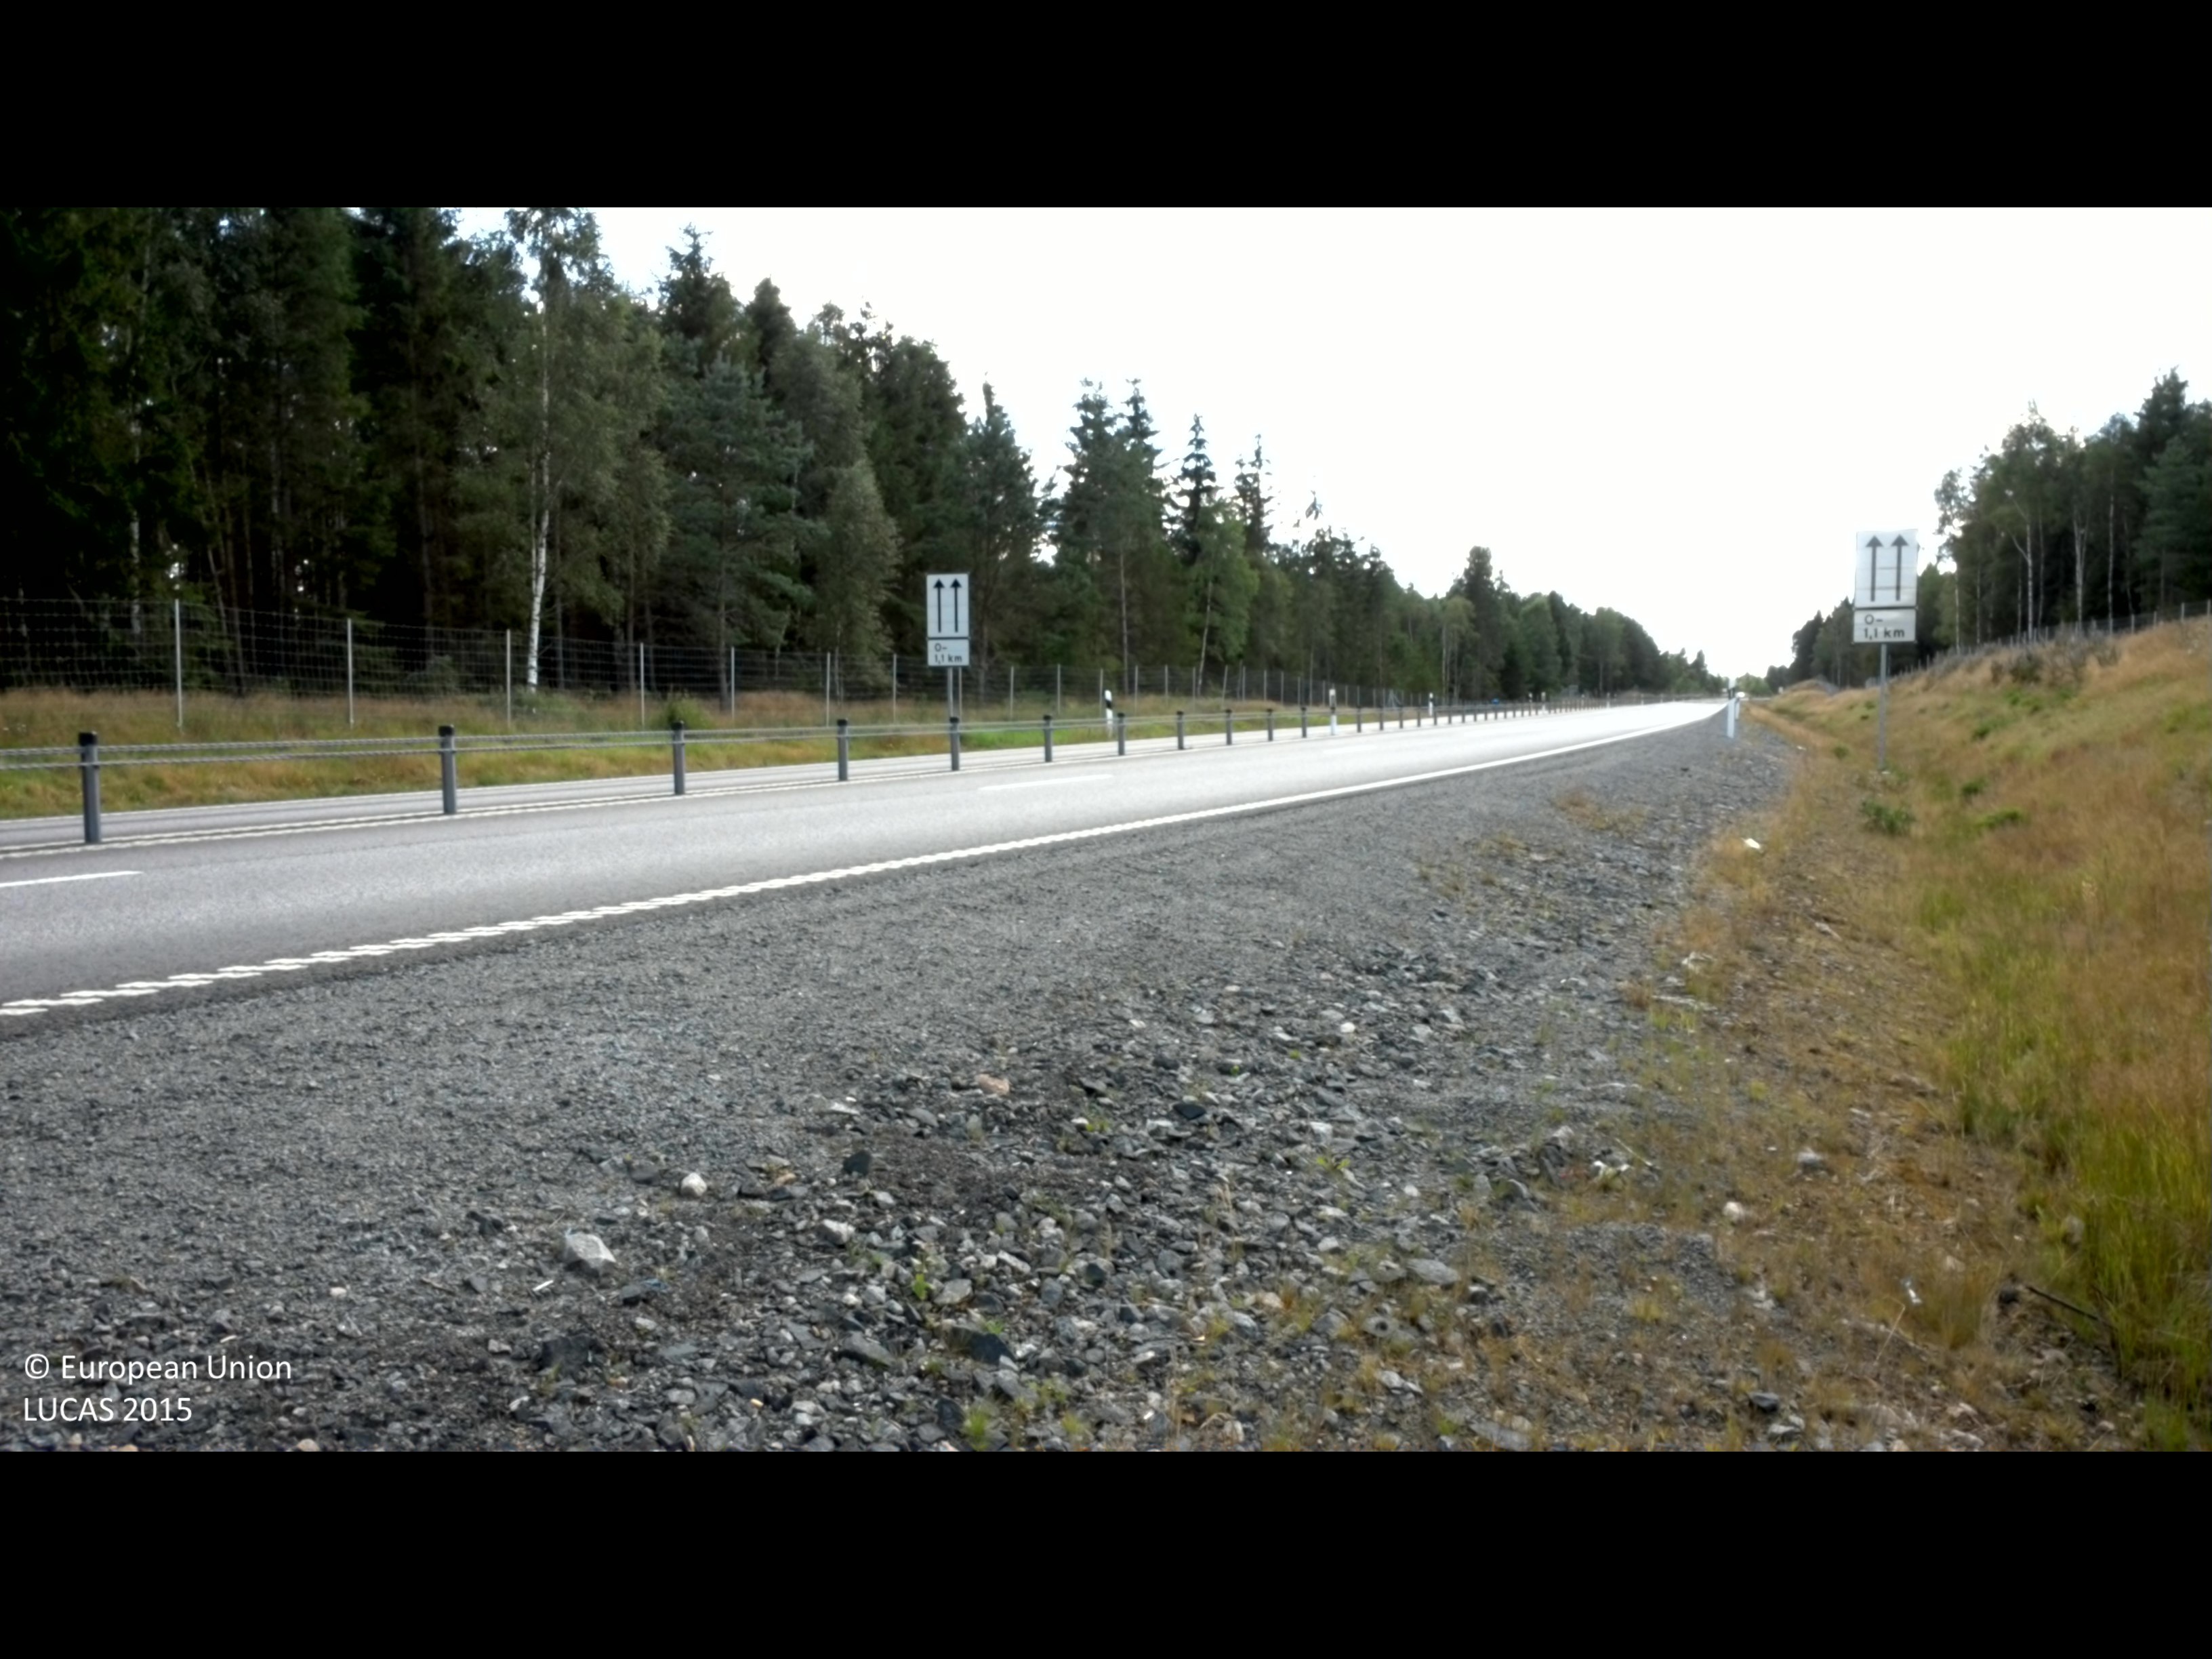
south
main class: Grassland
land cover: Grassland without tree/shrub cover
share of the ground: > 75 %
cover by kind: herbaceous plants 90 %, consolidated bare surface 10 %
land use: Road transport
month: August
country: SE
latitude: 56.6564
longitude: 14.2873
